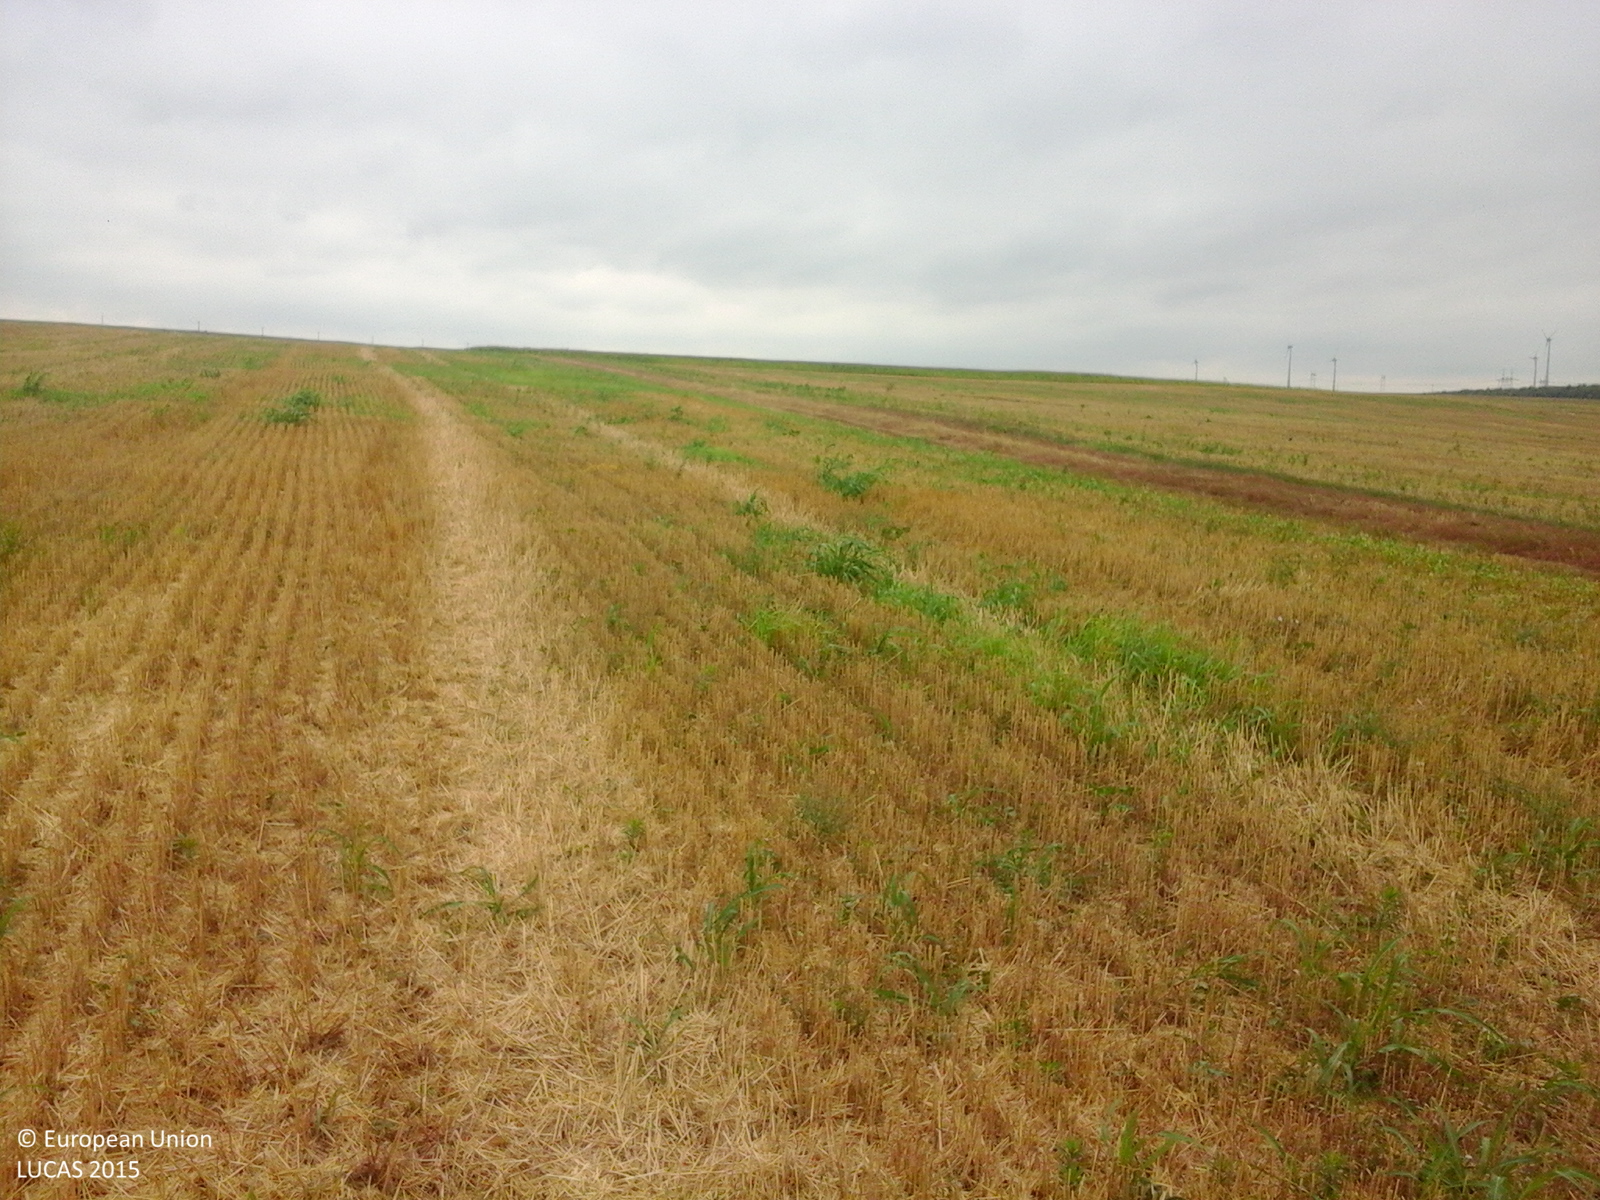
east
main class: Cropland
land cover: Durum wheat
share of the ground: 50 - 75 %
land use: Agriculture (excluding fallow land and kitchen gardens)
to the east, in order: Durum wheat; Tracks; Durum wheat
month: August
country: RO
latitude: 44.8424
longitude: 28.2221
